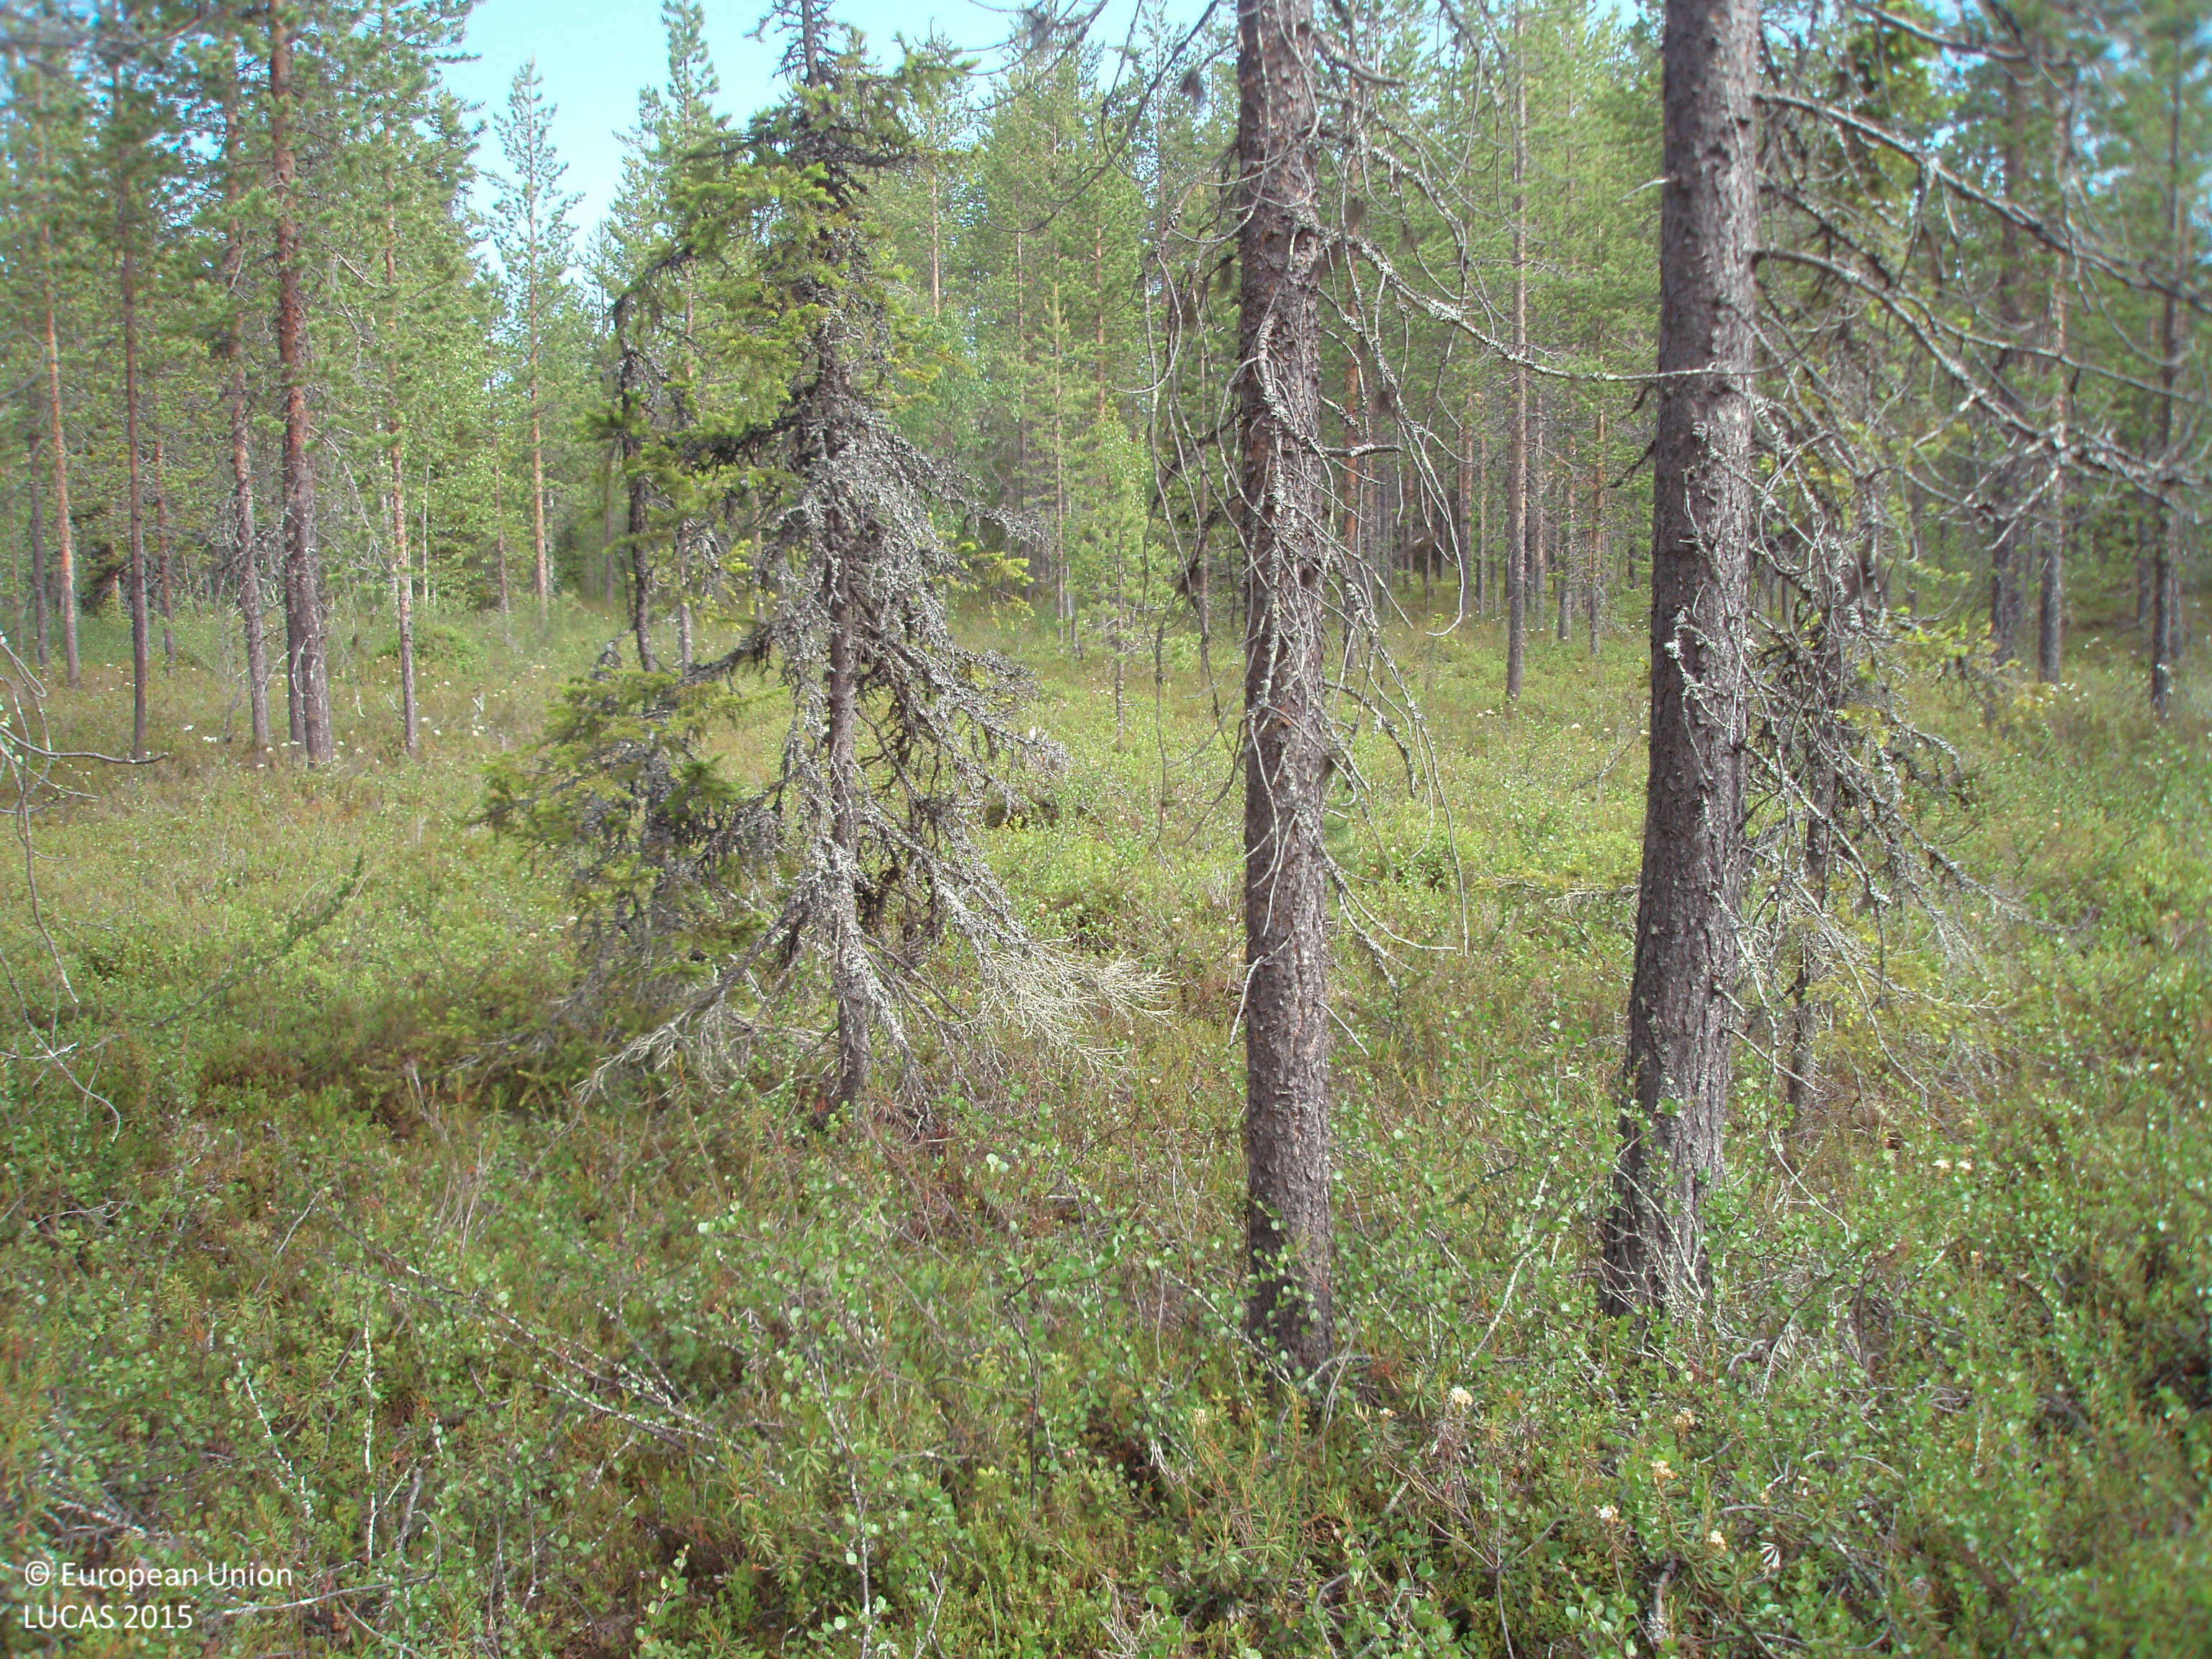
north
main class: Woodland
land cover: Pine dominated coniferous woodland
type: boreal forest
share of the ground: 50 - 75 %
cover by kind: coniferous forest trees 50 %, shrubs 40 %, broadleaved forest trees 10 %
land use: Forestry
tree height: > 5 m
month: July
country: FI
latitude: 67.8245
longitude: 27.7875
